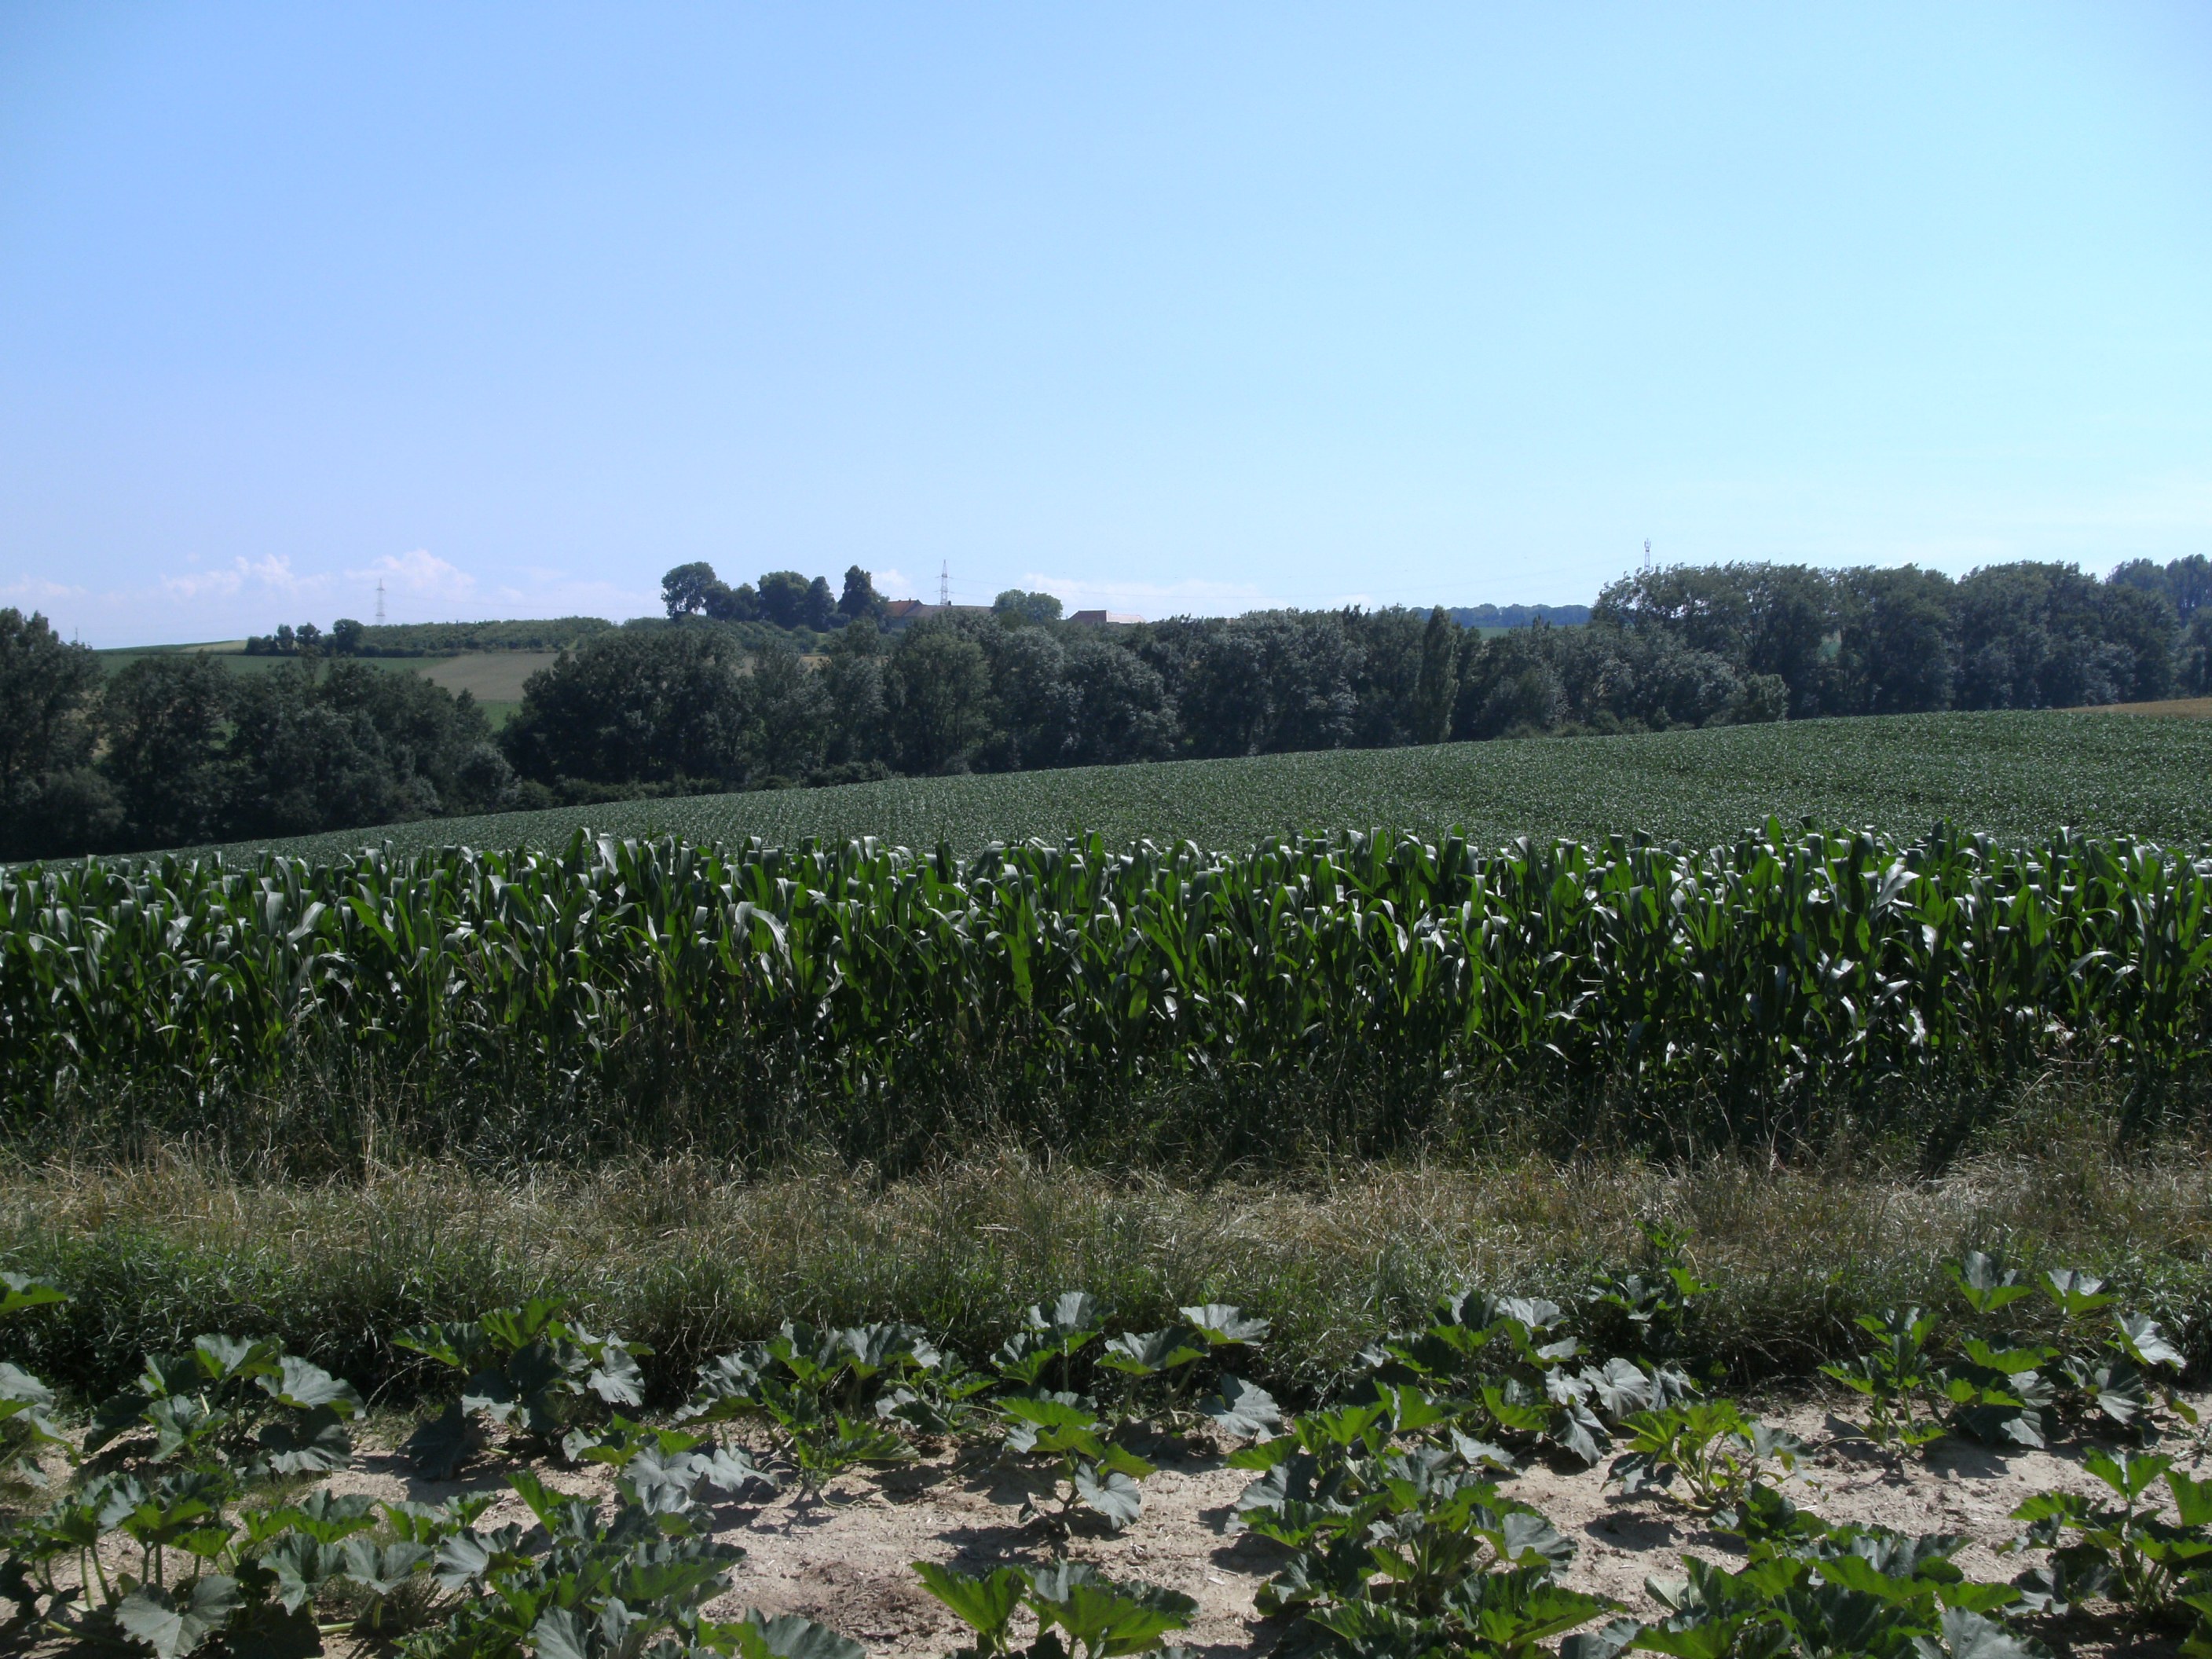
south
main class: Cropland
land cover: Other fresh vegetables
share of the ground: 50 - 75 %
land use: Agriculture (excluding fallow land and kitchen gardens)
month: July
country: AT
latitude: 48.2880
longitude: 14.1915
